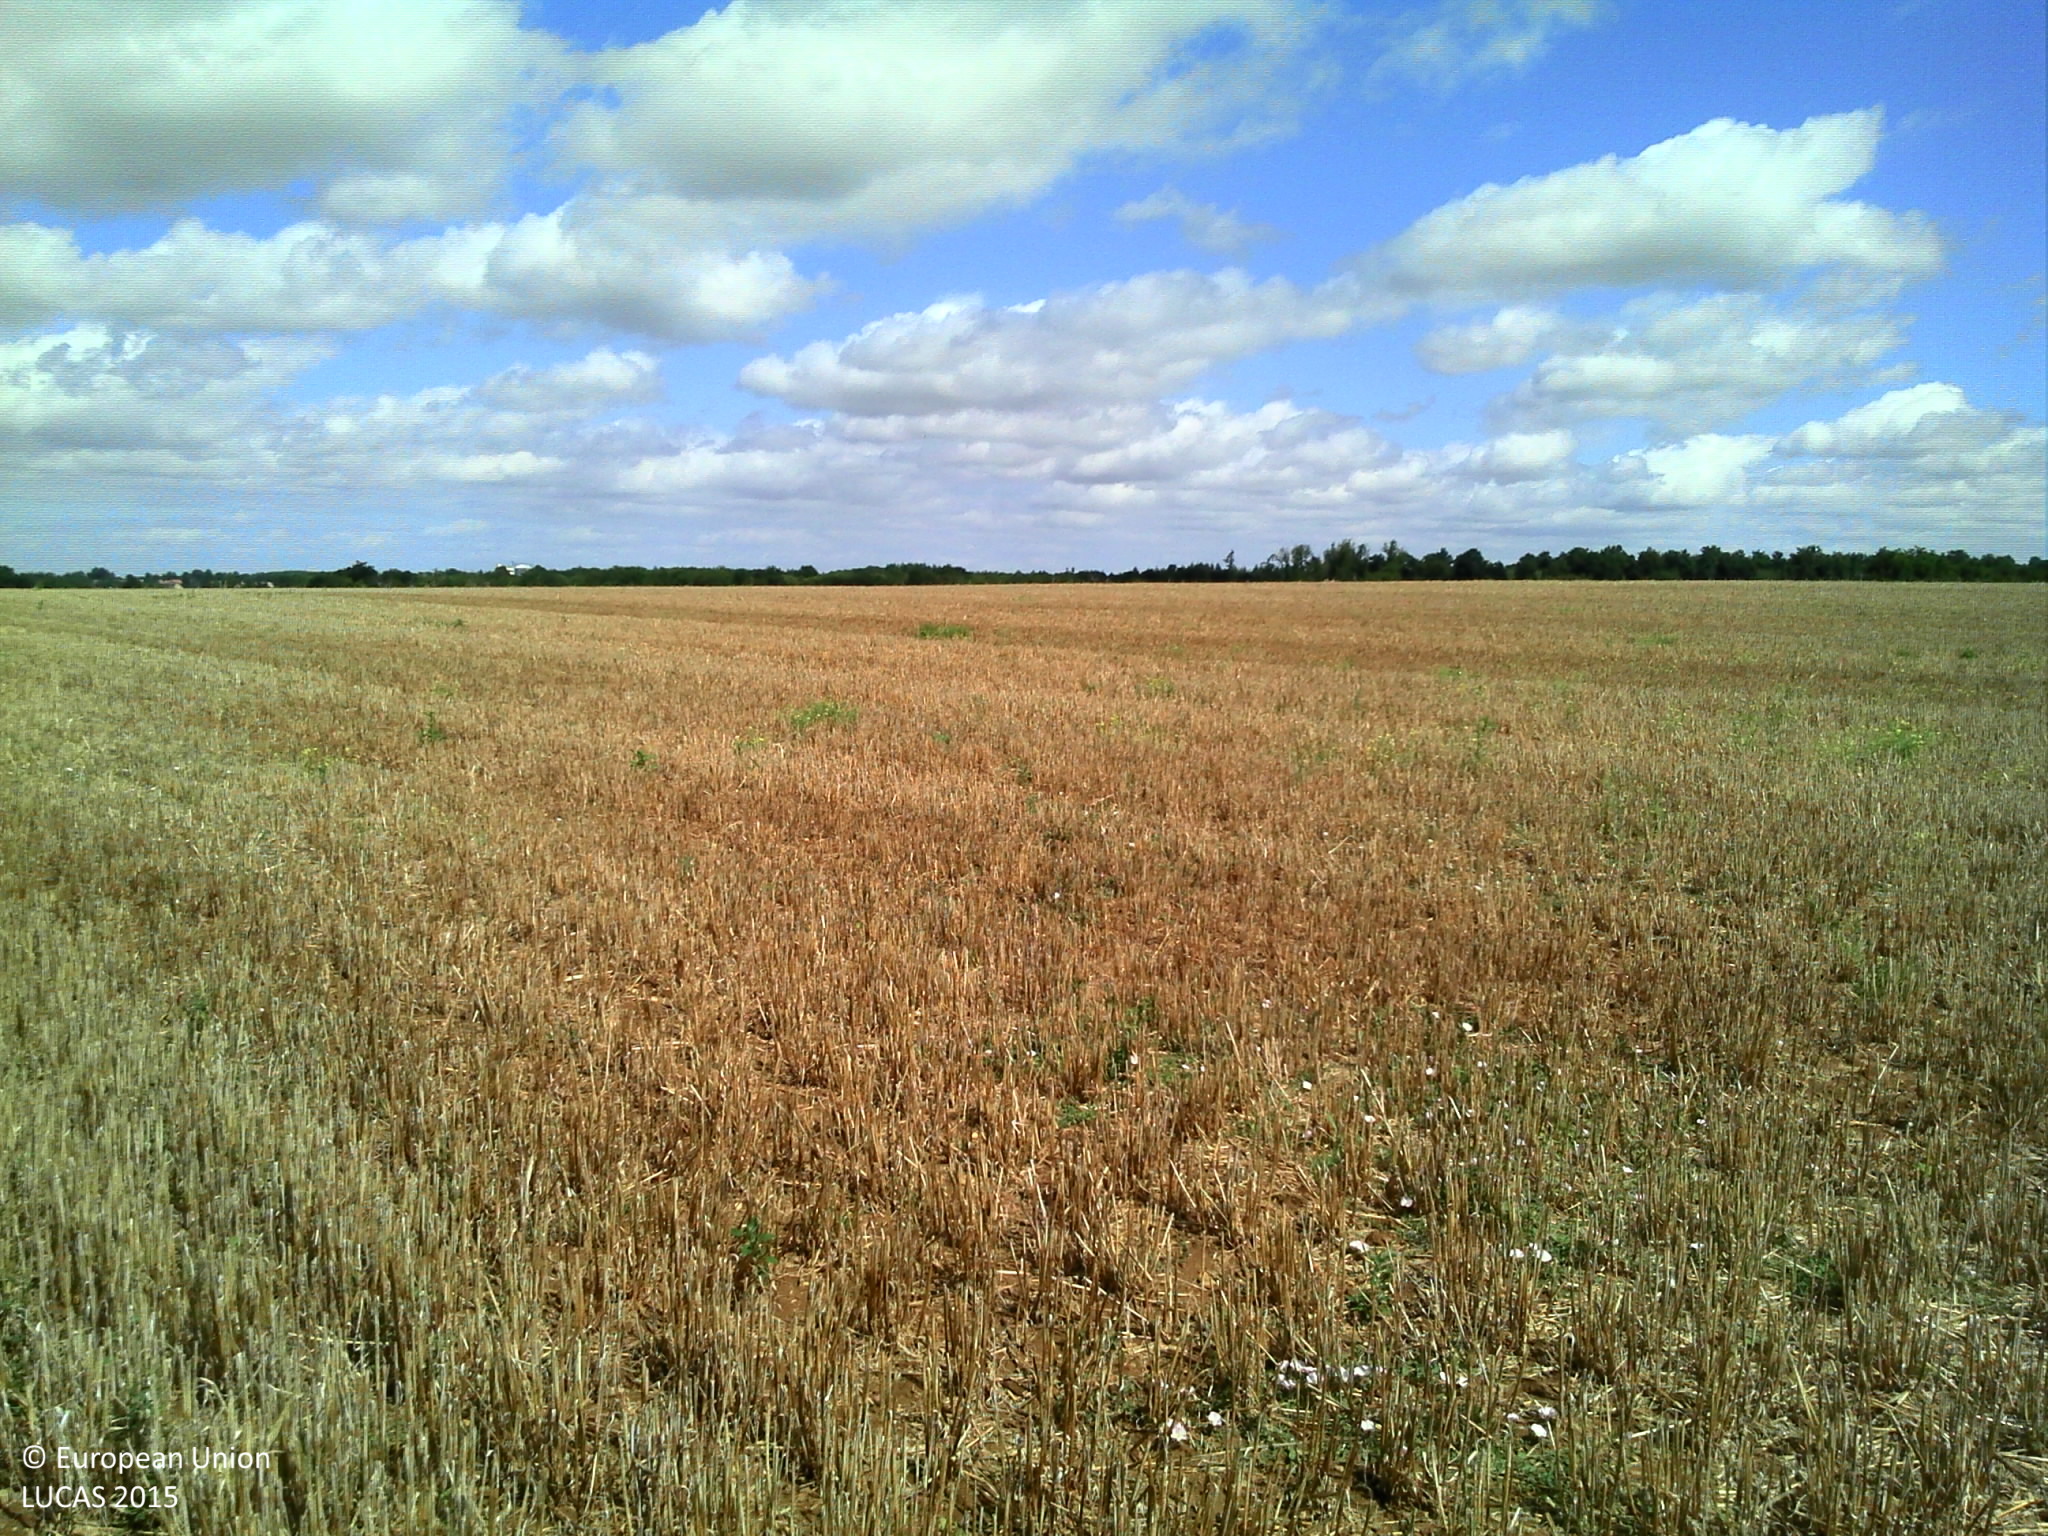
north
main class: Cropland
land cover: Barley
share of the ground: 50 - 75 %
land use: Agriculture (excluding fallow land and kitchen gardens)
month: August
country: FR
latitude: 46.0950
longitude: 0.3468
